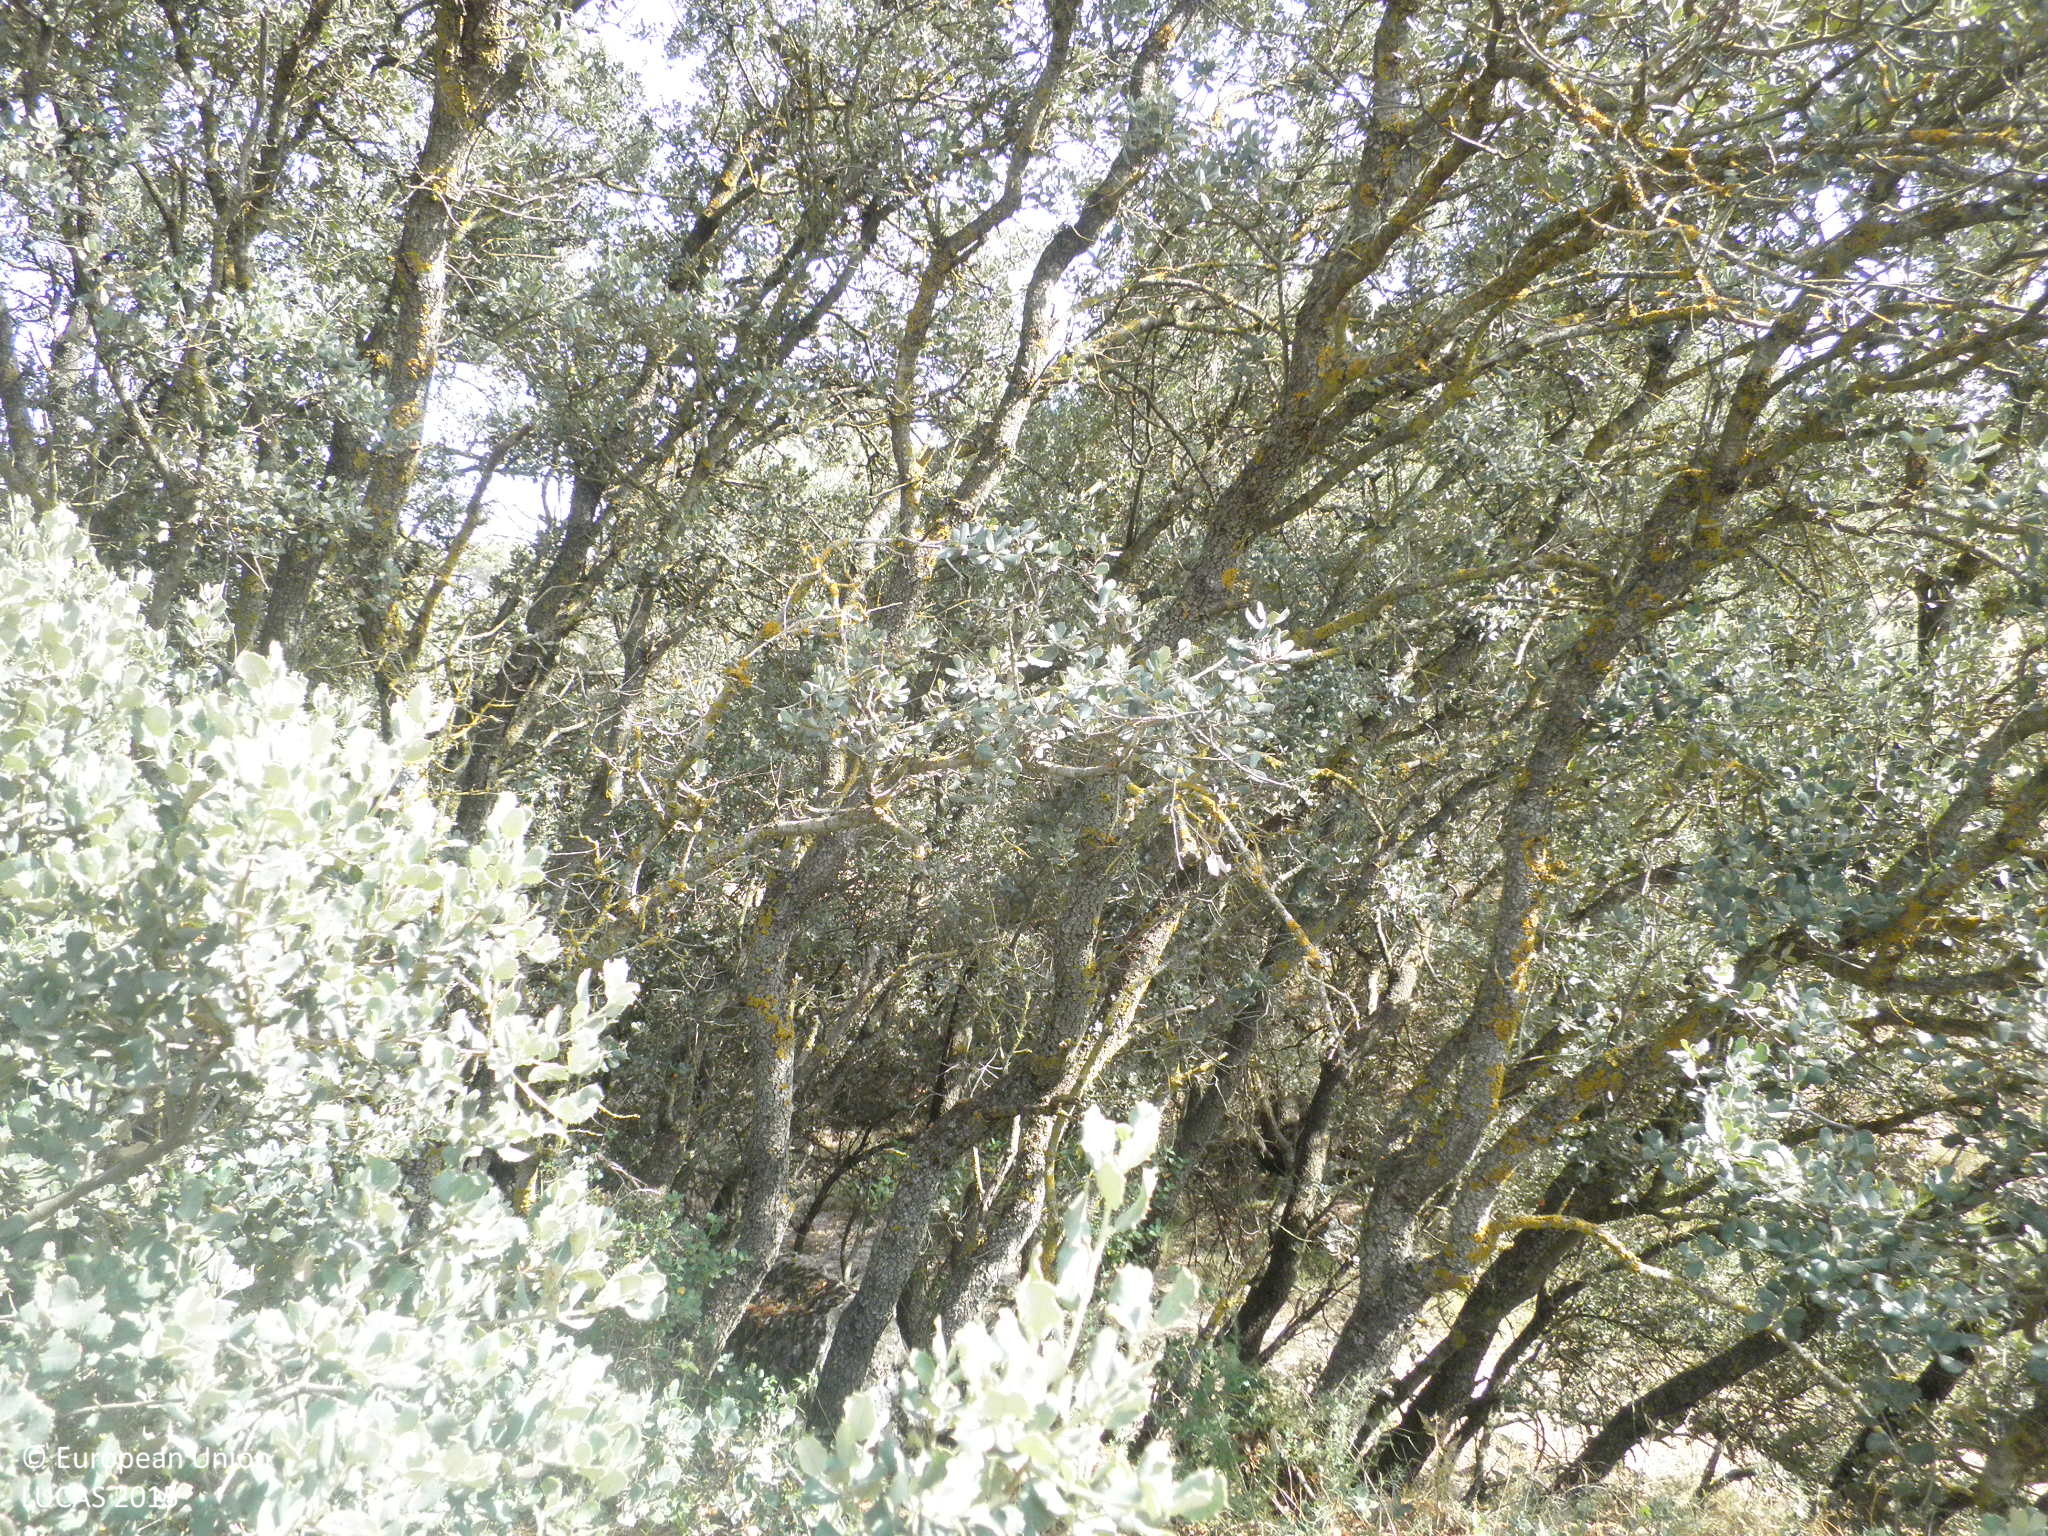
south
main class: Woodland
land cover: Broadleaved woodland
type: broadleaved evergreen forest
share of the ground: 25 - 50 %
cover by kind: herbaceous plants 55 %, broadleaved forest trees 30 %, consolidated bare surface 10 %, shrubs 5 %
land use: Semi-natural and natural areas not in use
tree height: > 5 m
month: July
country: ES
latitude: 39.5261
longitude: -2.5889
